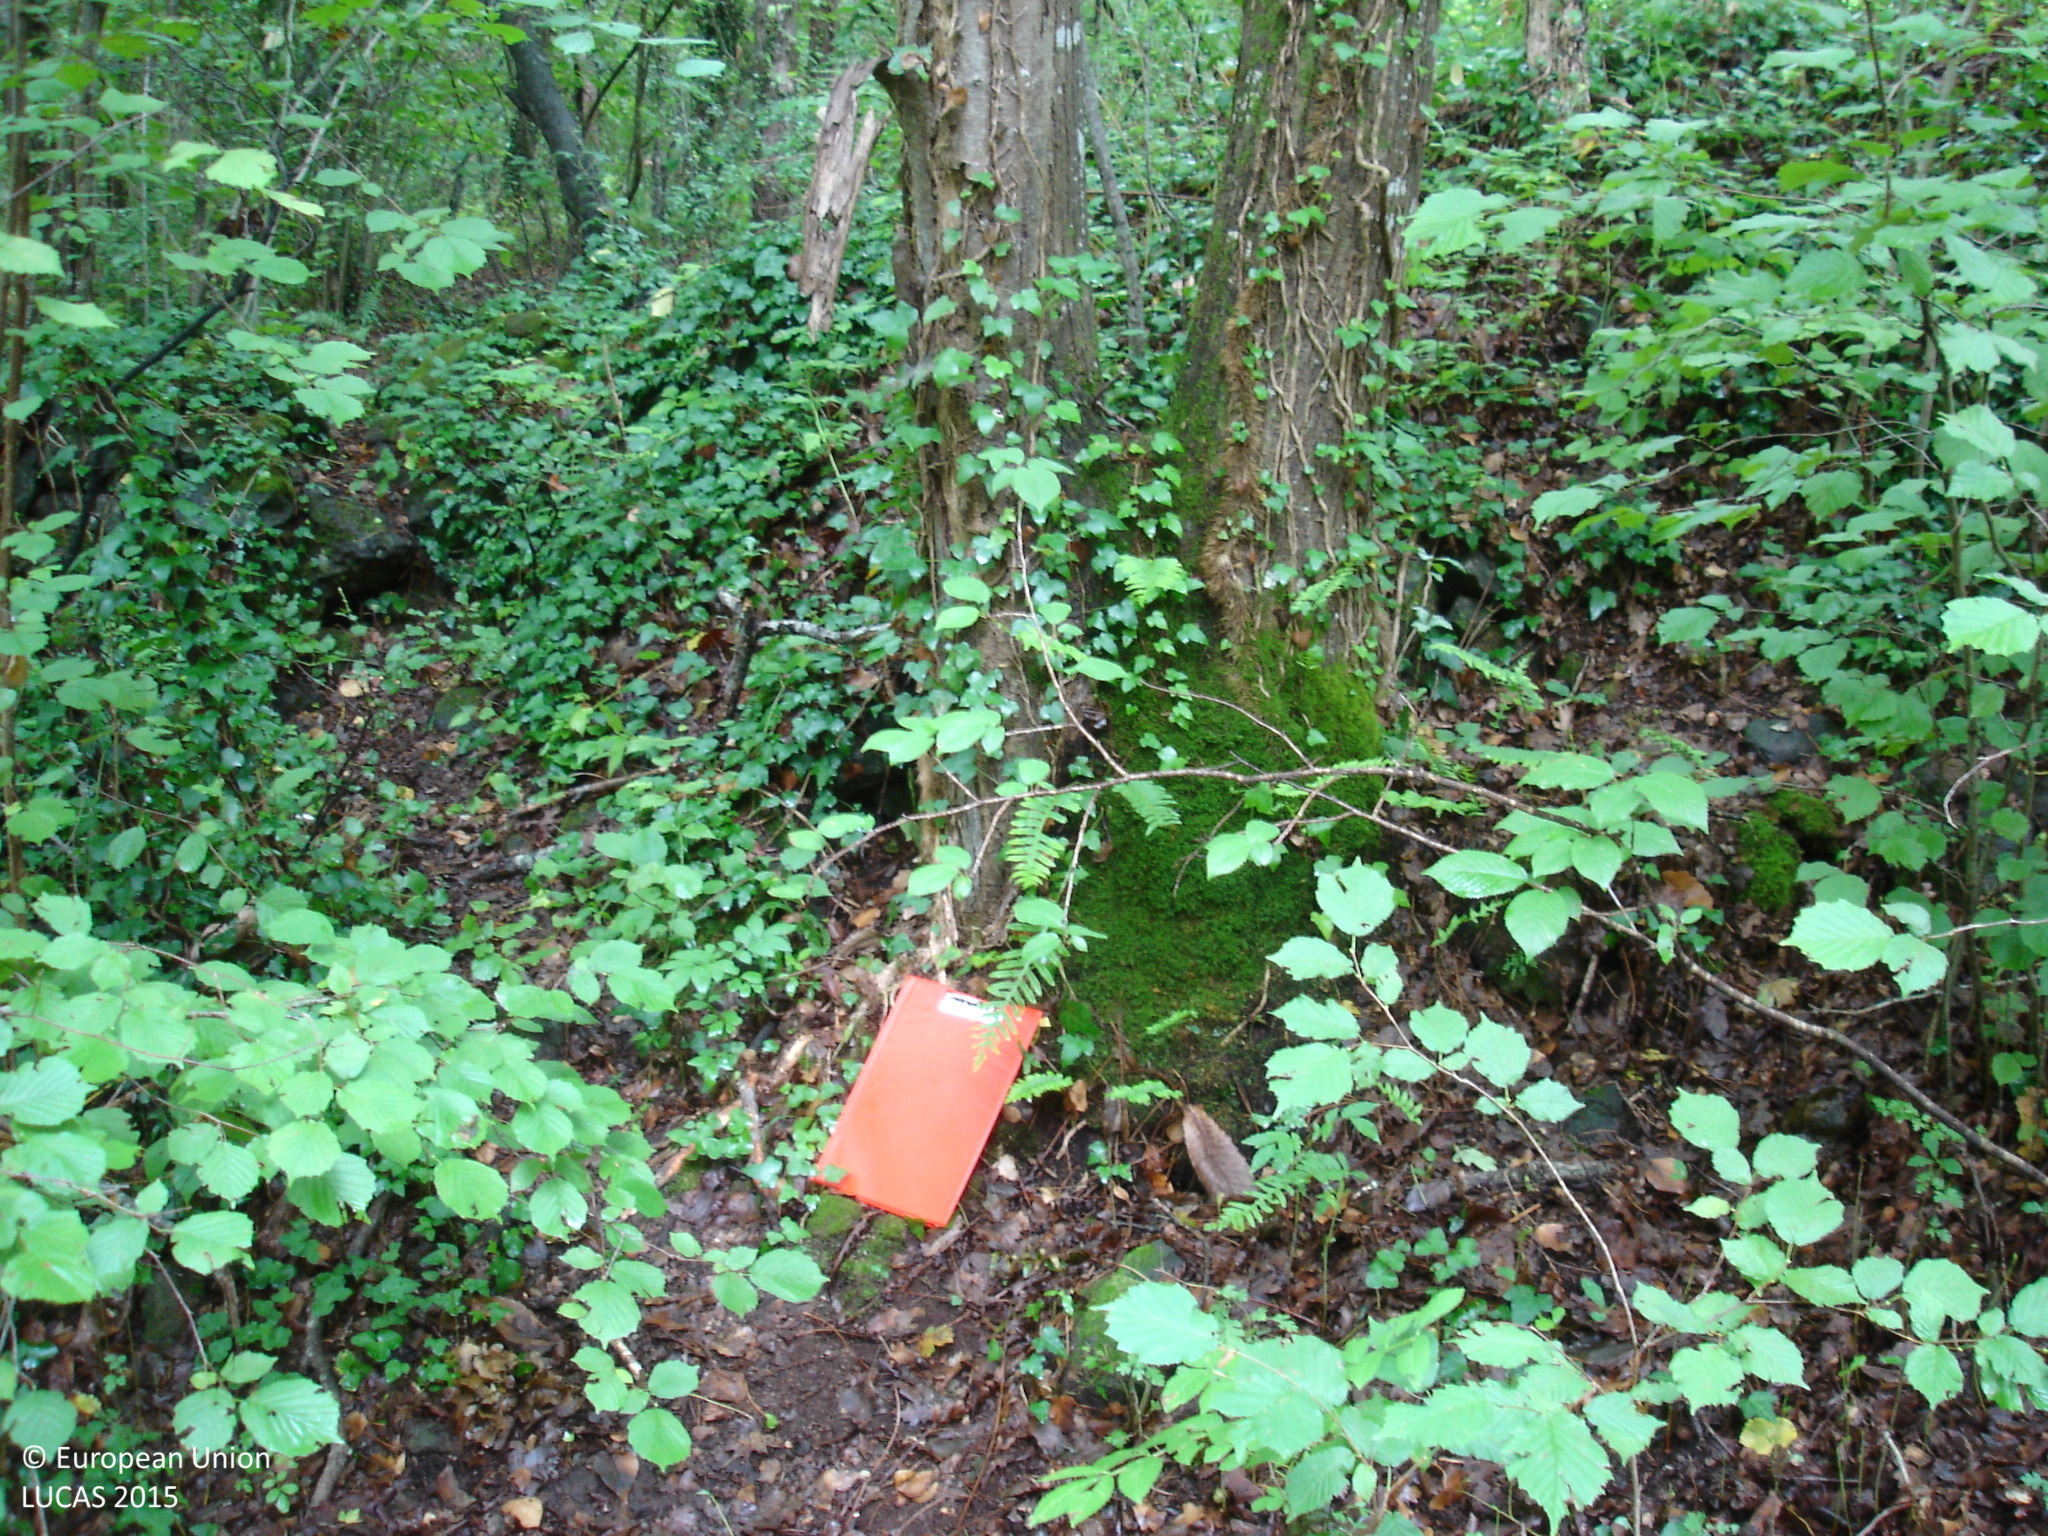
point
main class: Woodland
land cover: Broadleaved woodland
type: thermophilous deciduous forest
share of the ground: > 75 %
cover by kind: broadleaved forest trees 100 %
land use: Forestry
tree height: > 5 m
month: July
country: ES
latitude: 42.1580
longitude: 2.4983
